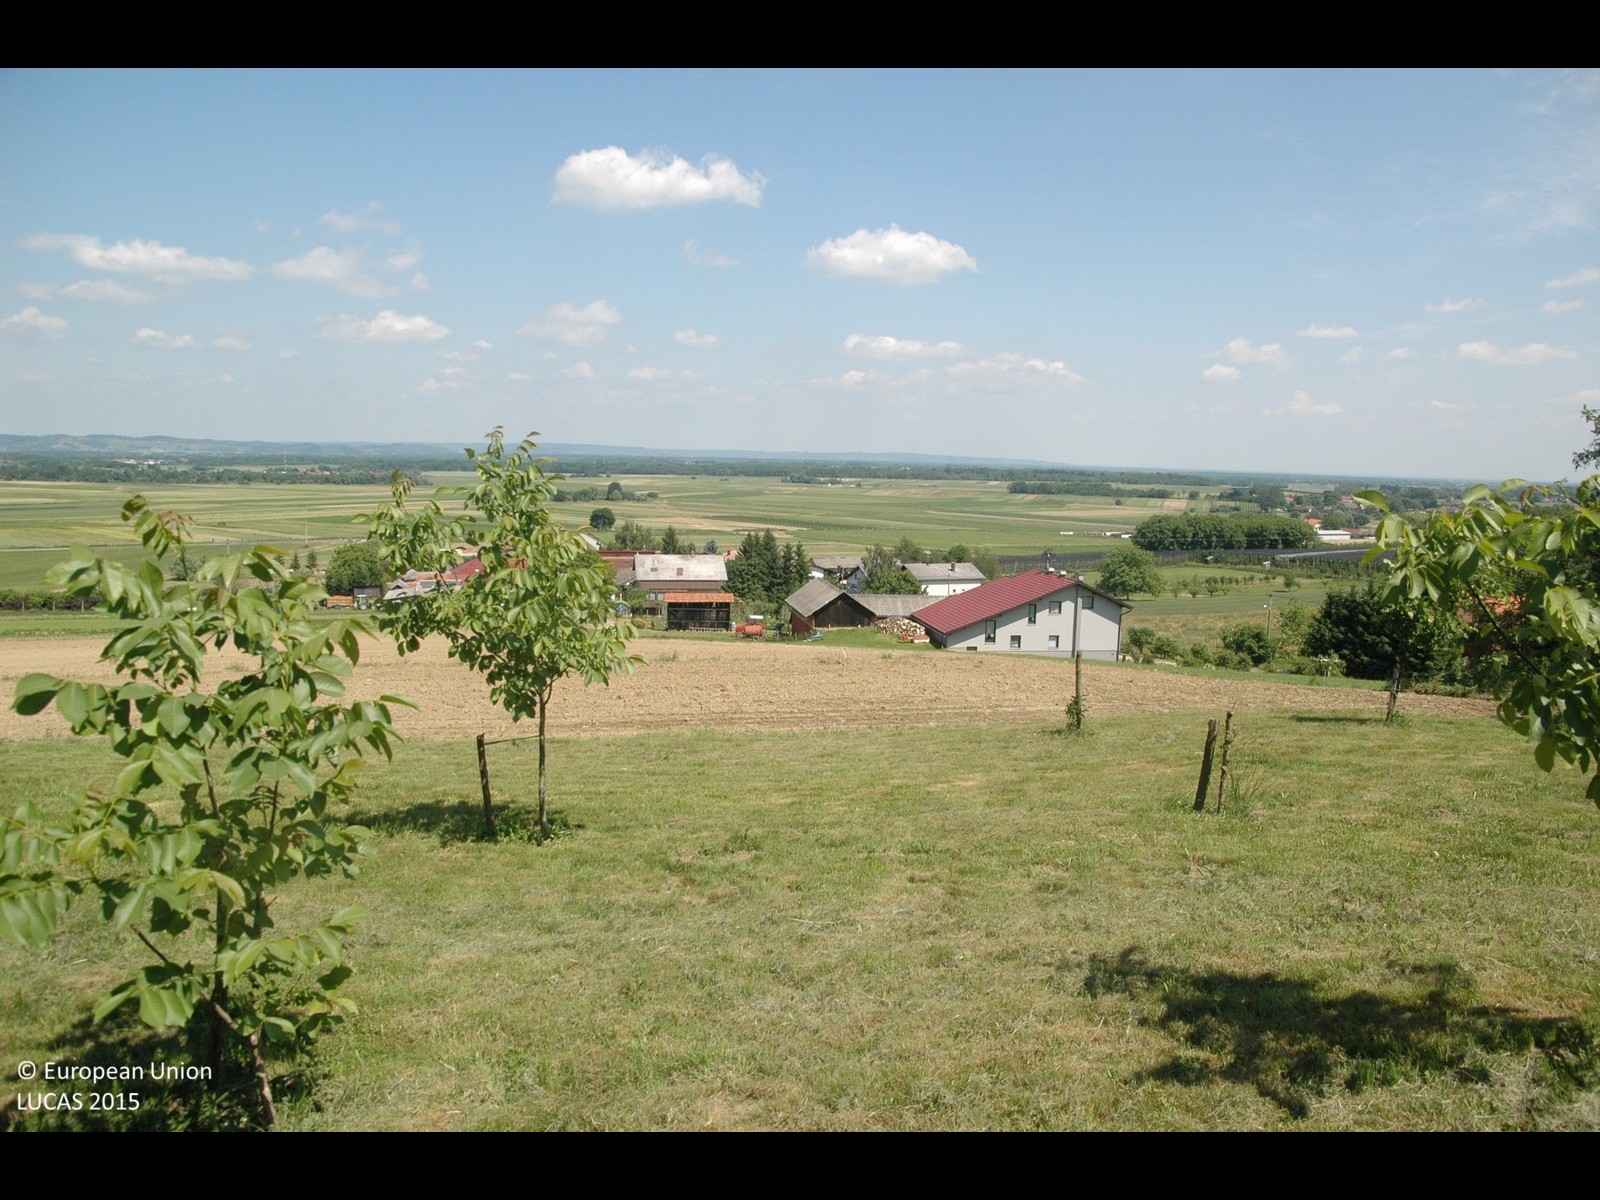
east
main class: Cropland
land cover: Nuts trees
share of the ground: 10 - 25 %
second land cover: Grassland without tree/shrub cover
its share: 50 - 75 %
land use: Agriculture (excluding fallow land and kitchen gardens)
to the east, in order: Nuts trees; Grassland without tree/shrub cover; Maize; Artificial constructions in urban areas
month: May
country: HR
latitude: 46.4849
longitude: 16.3969
